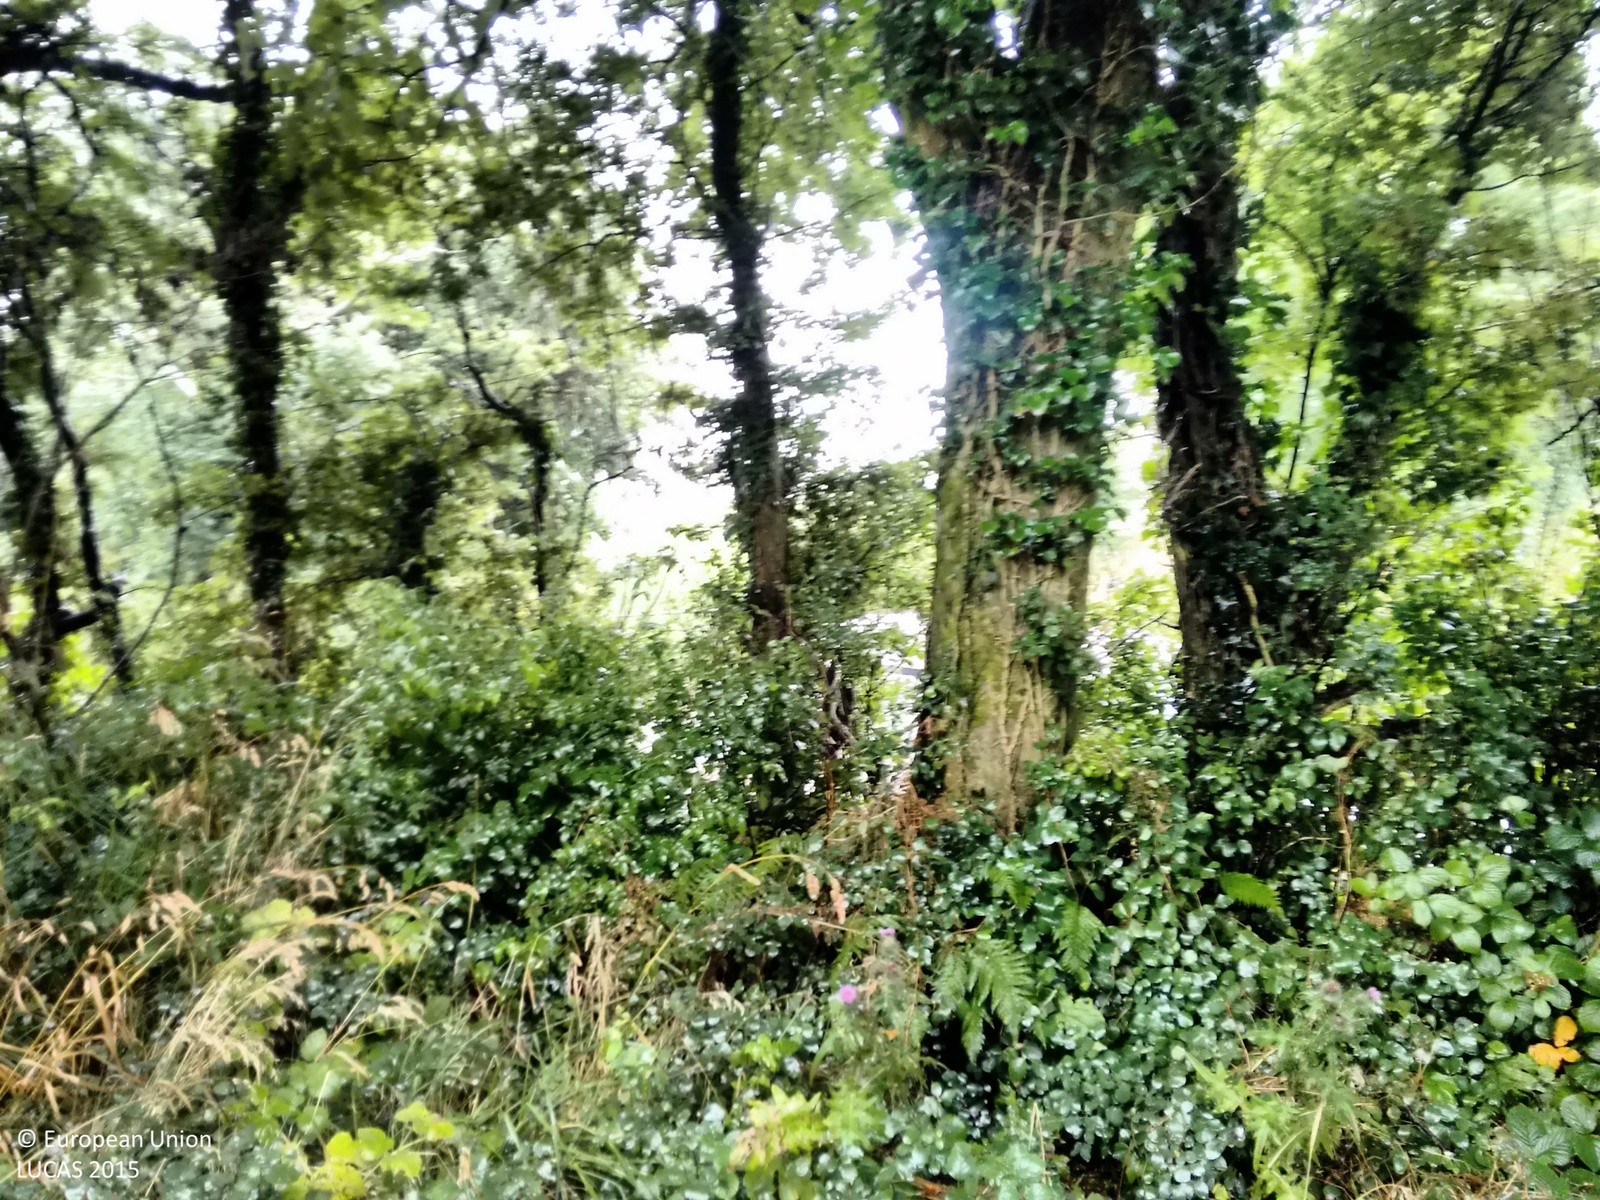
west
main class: Woodland
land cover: Broadleaved woodland
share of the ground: > 75 %
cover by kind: broadleaved forest trees 95 %, herbaceous plants 5 %
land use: Residential
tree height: > 5 m
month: August
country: IE
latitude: 52.4836
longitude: -6.3356
